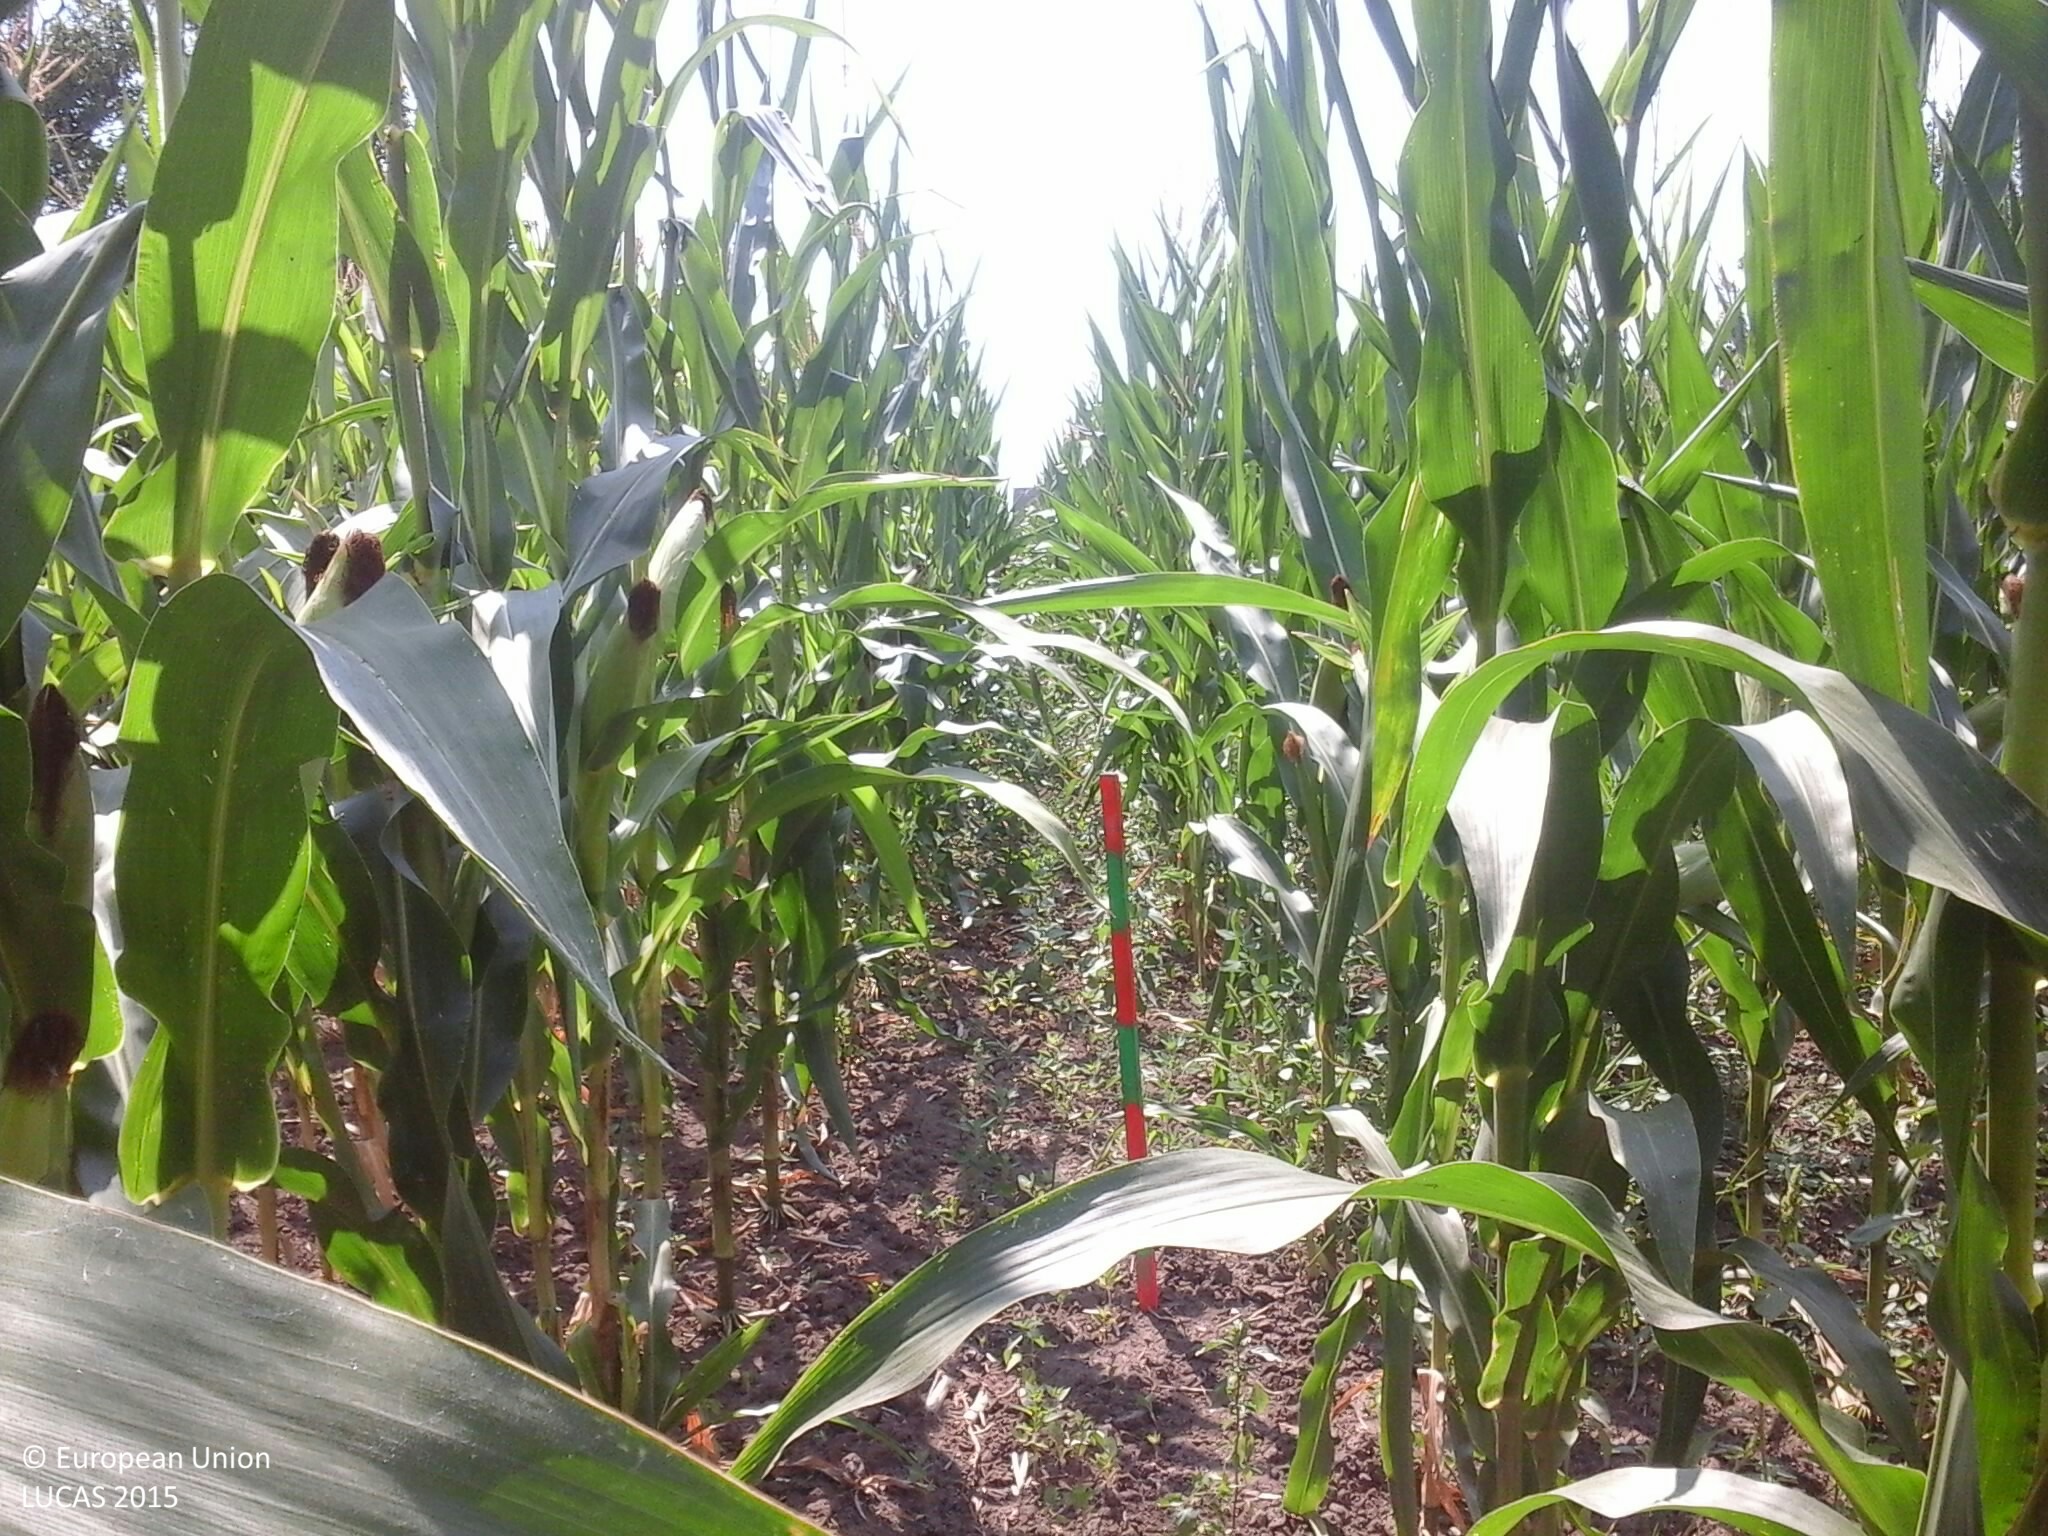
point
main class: Cropland
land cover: Maize
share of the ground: > 75 %
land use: Agriculture (excluding fallow land and kitchen gardens)
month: August
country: HU
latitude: 47.0088
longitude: 18.2578
